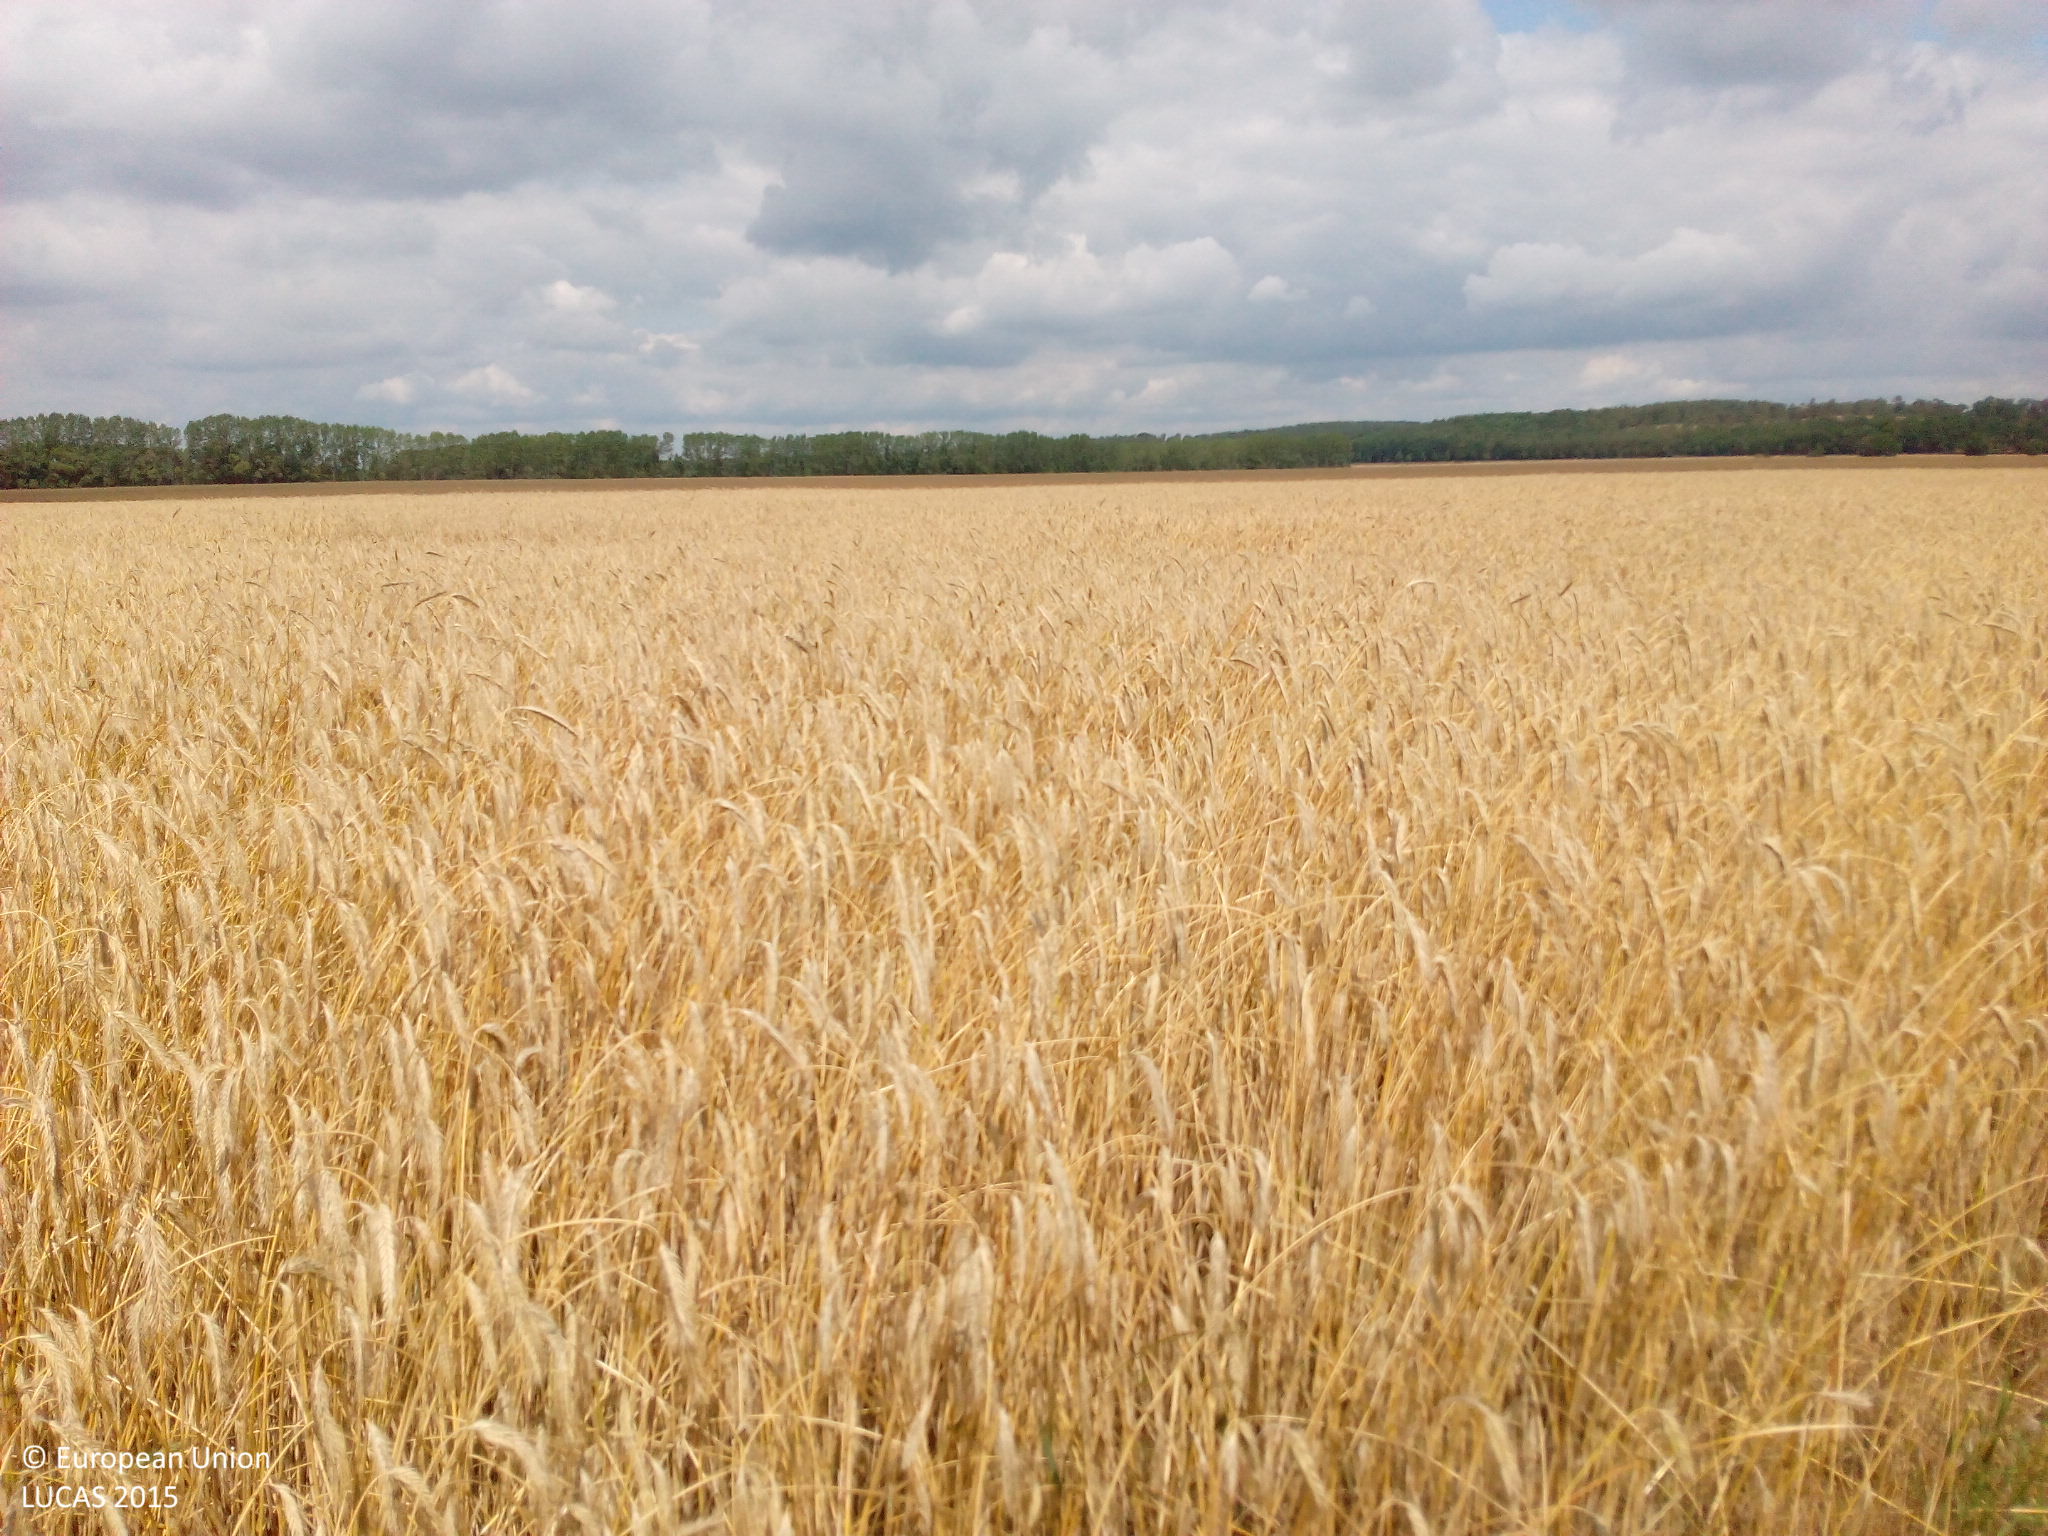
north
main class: Cropland
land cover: Rye
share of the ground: > 75 %
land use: Agriculture (excluding fallow land and kitchen gardens)
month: July
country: DE
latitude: 52.6779
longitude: 12.3512
